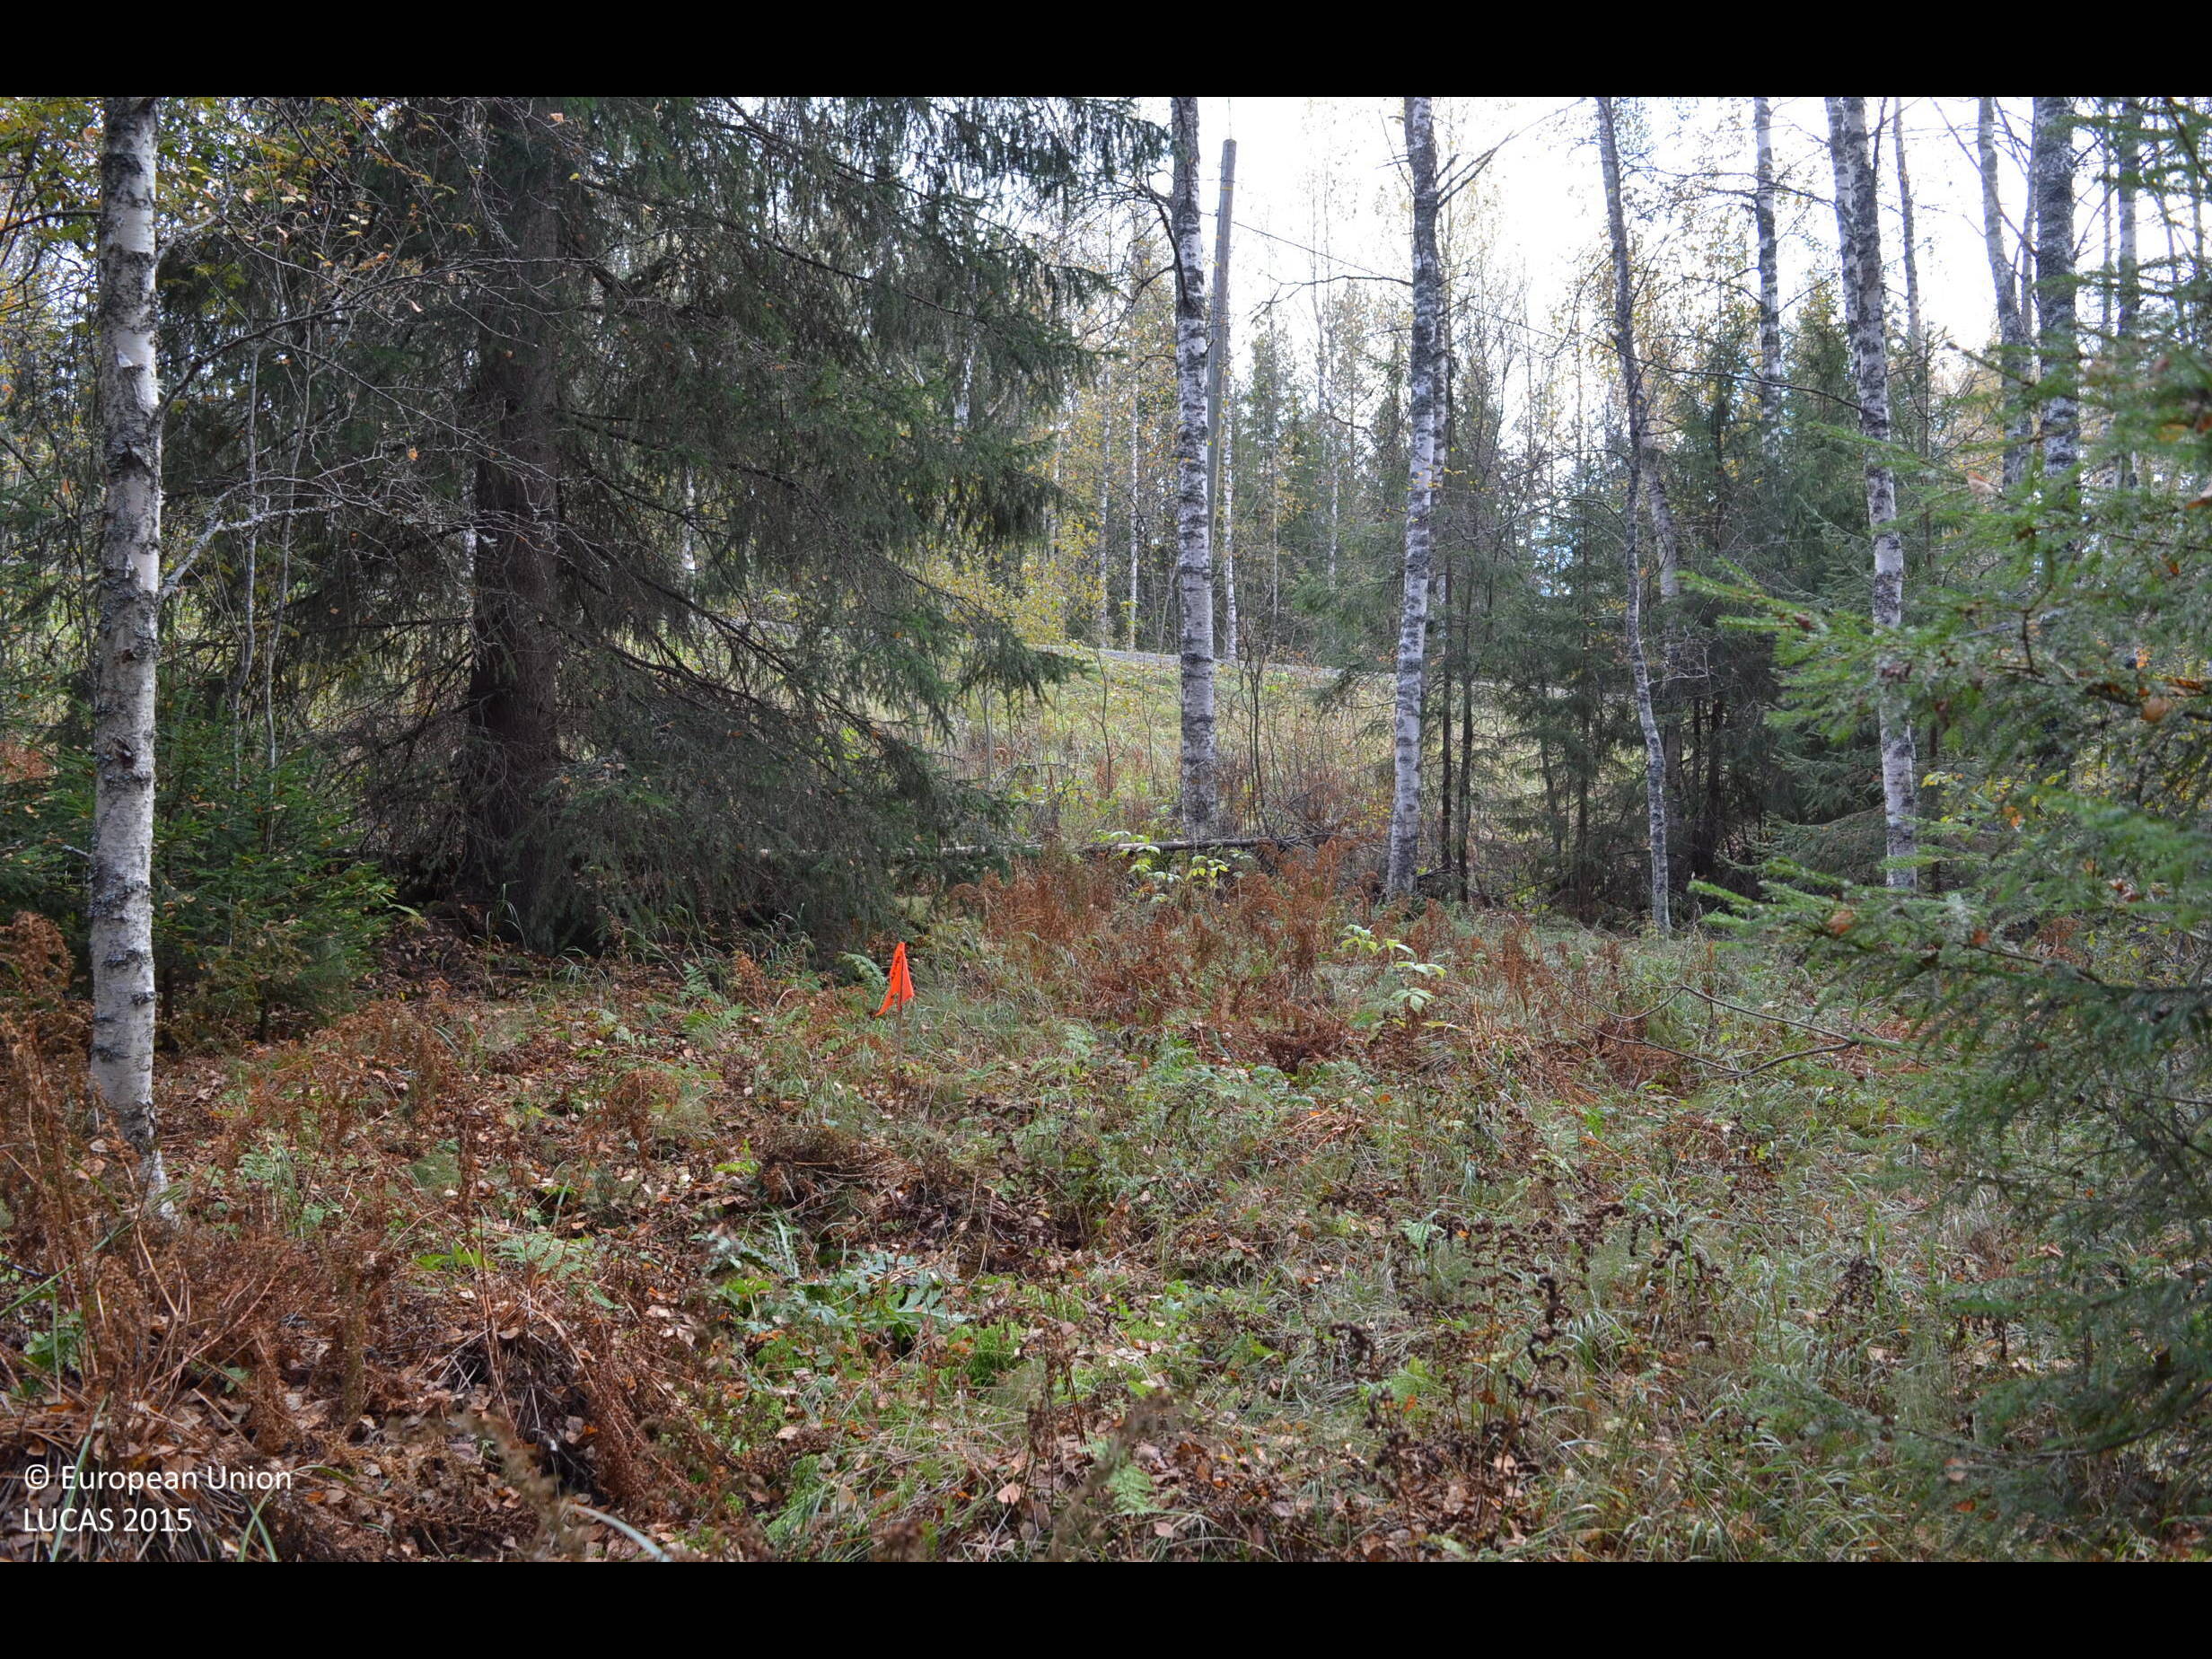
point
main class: Woodland
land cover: Spruce dominated mixed woodland
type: boreal forest
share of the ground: 50 - 75 %
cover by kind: coniferous forest trees 35 %, broadleaved forest trees 35 %, herbaceous plants 25 %, shrubs 5 %
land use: Forestry
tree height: > 5 m
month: October
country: FI
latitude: 61.6914
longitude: 23.8647
